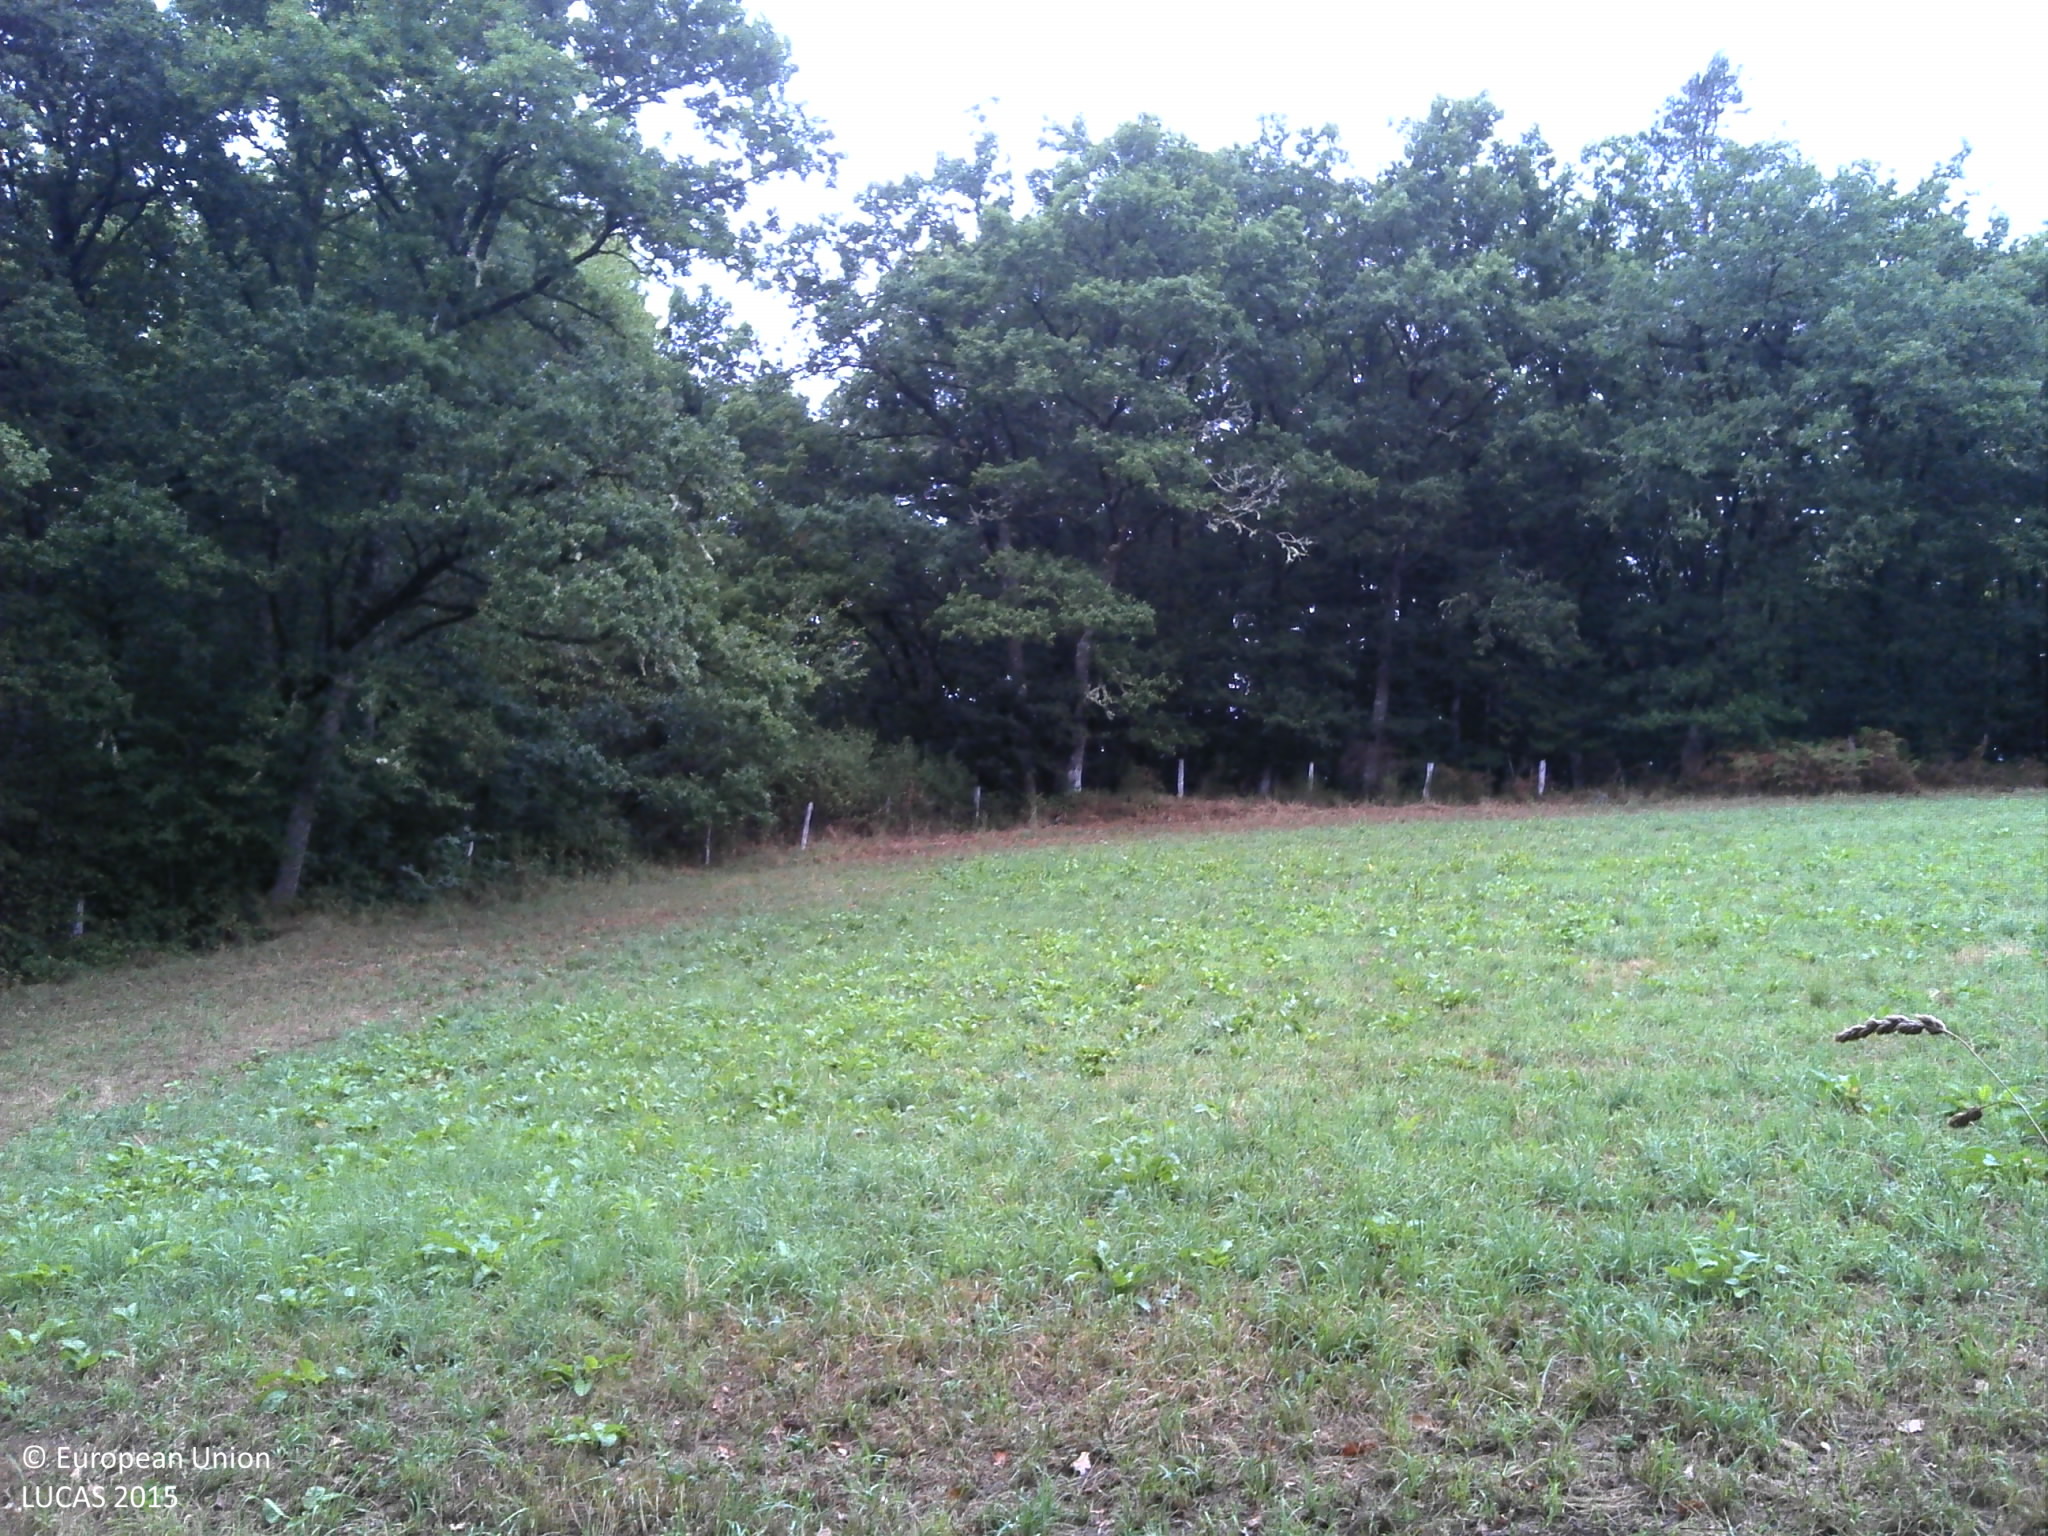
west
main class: Grassland
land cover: Grassland without tree/shrub cover
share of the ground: > 75 %
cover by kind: herbaceous plants 90 %, unconsolidated bare surface 10 %
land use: Agriculture (excluding fallow land and kitchen gardens)
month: August
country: FR
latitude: 45.4306
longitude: 2.4187
